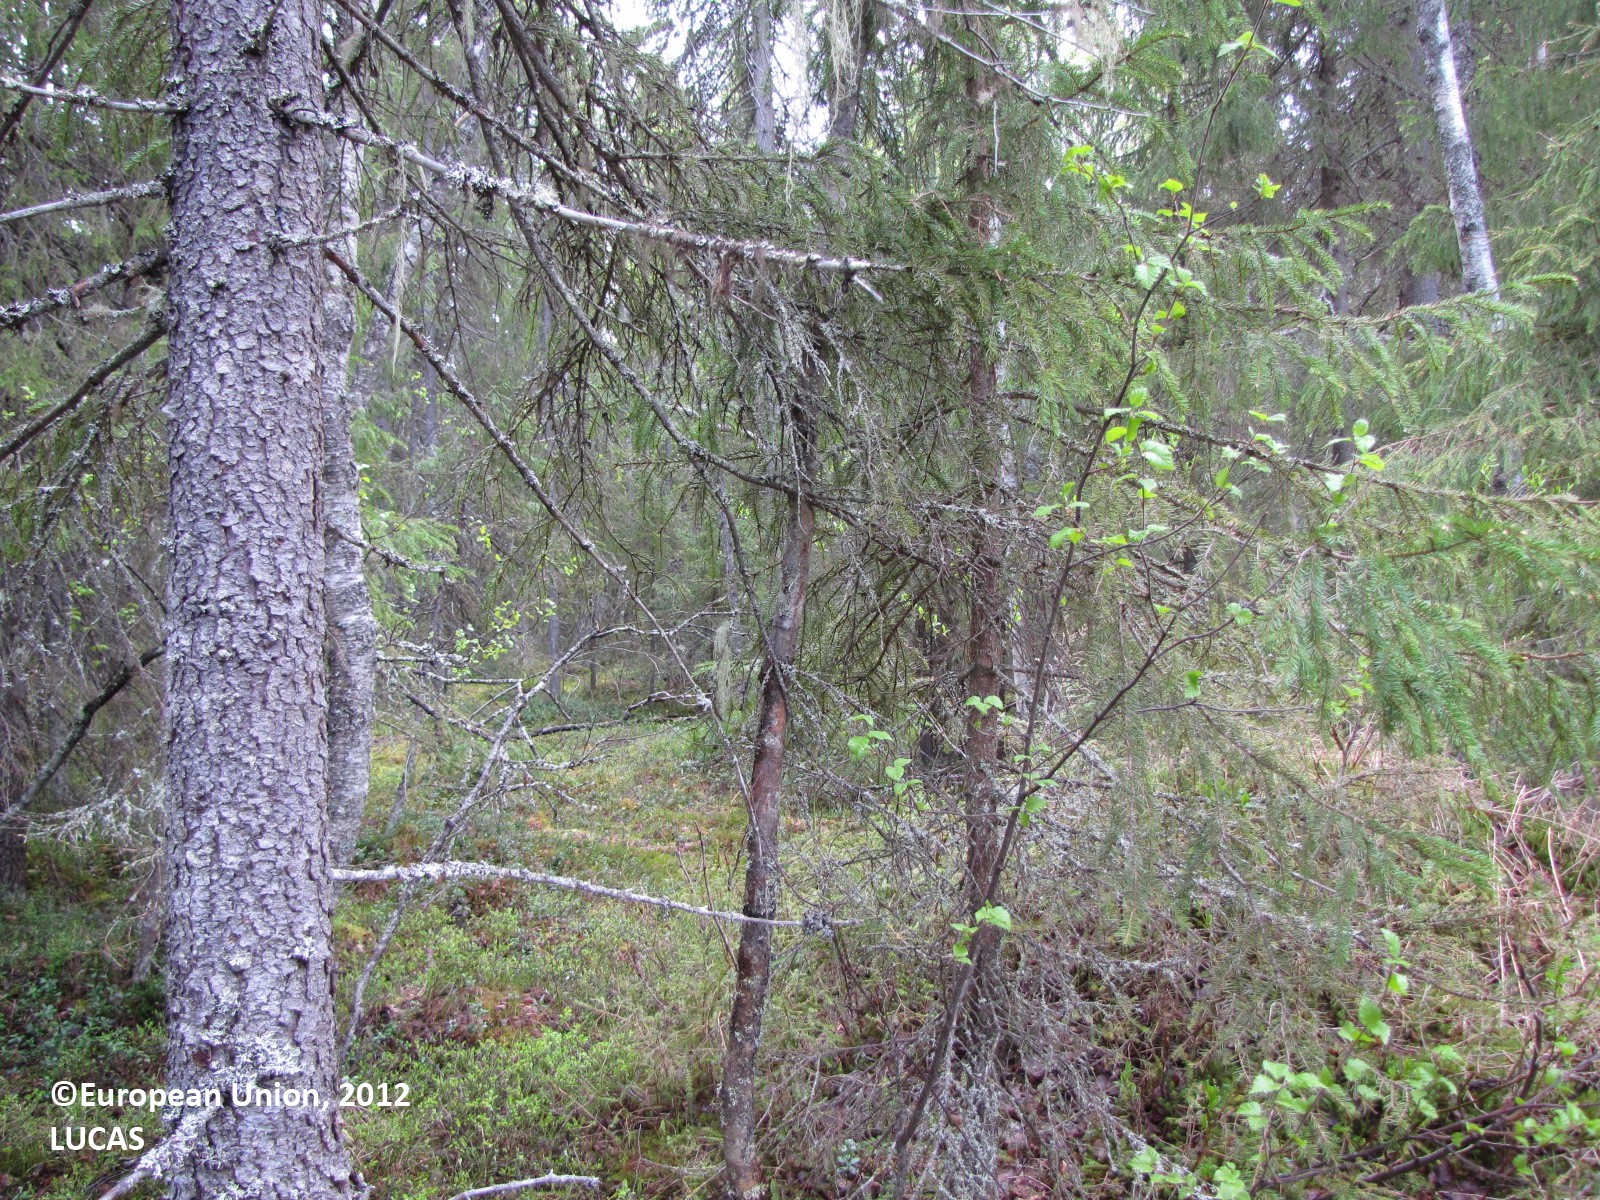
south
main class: Woodland
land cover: Spruce dominated coniferous woodland
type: boreal forest
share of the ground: 50 - 75 %
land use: Forestry
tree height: > 5 m
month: June
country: FI
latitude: 65.9324
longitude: 24.1764
